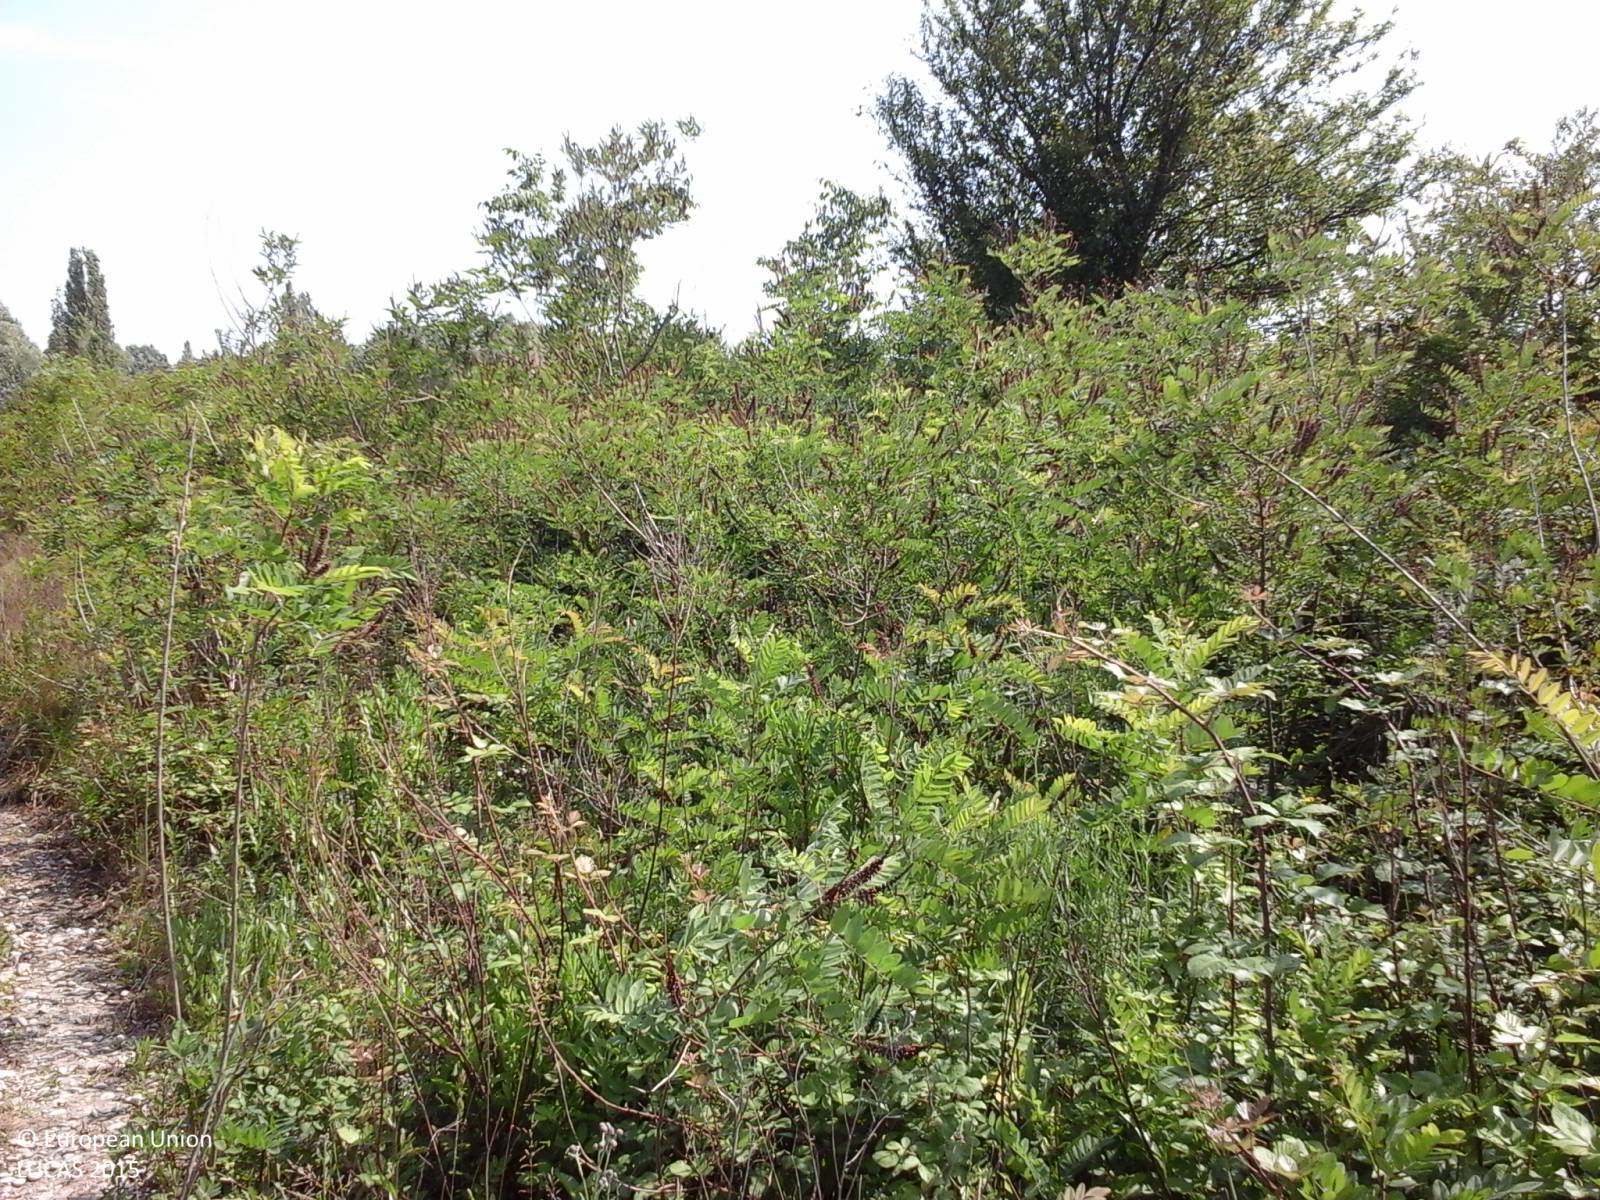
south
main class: Shrubland
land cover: Shrubland with sparse tree cover
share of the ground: > 75 %
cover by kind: shrubs 75 %, herbaceous plants 10 %, unconsolidated bare surface 10 %, broadleaved forest trees 5 %
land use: Semi-natural and natural areas not in use
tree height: > 5 m
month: May
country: IT
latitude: 45.6834
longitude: 13.4239
